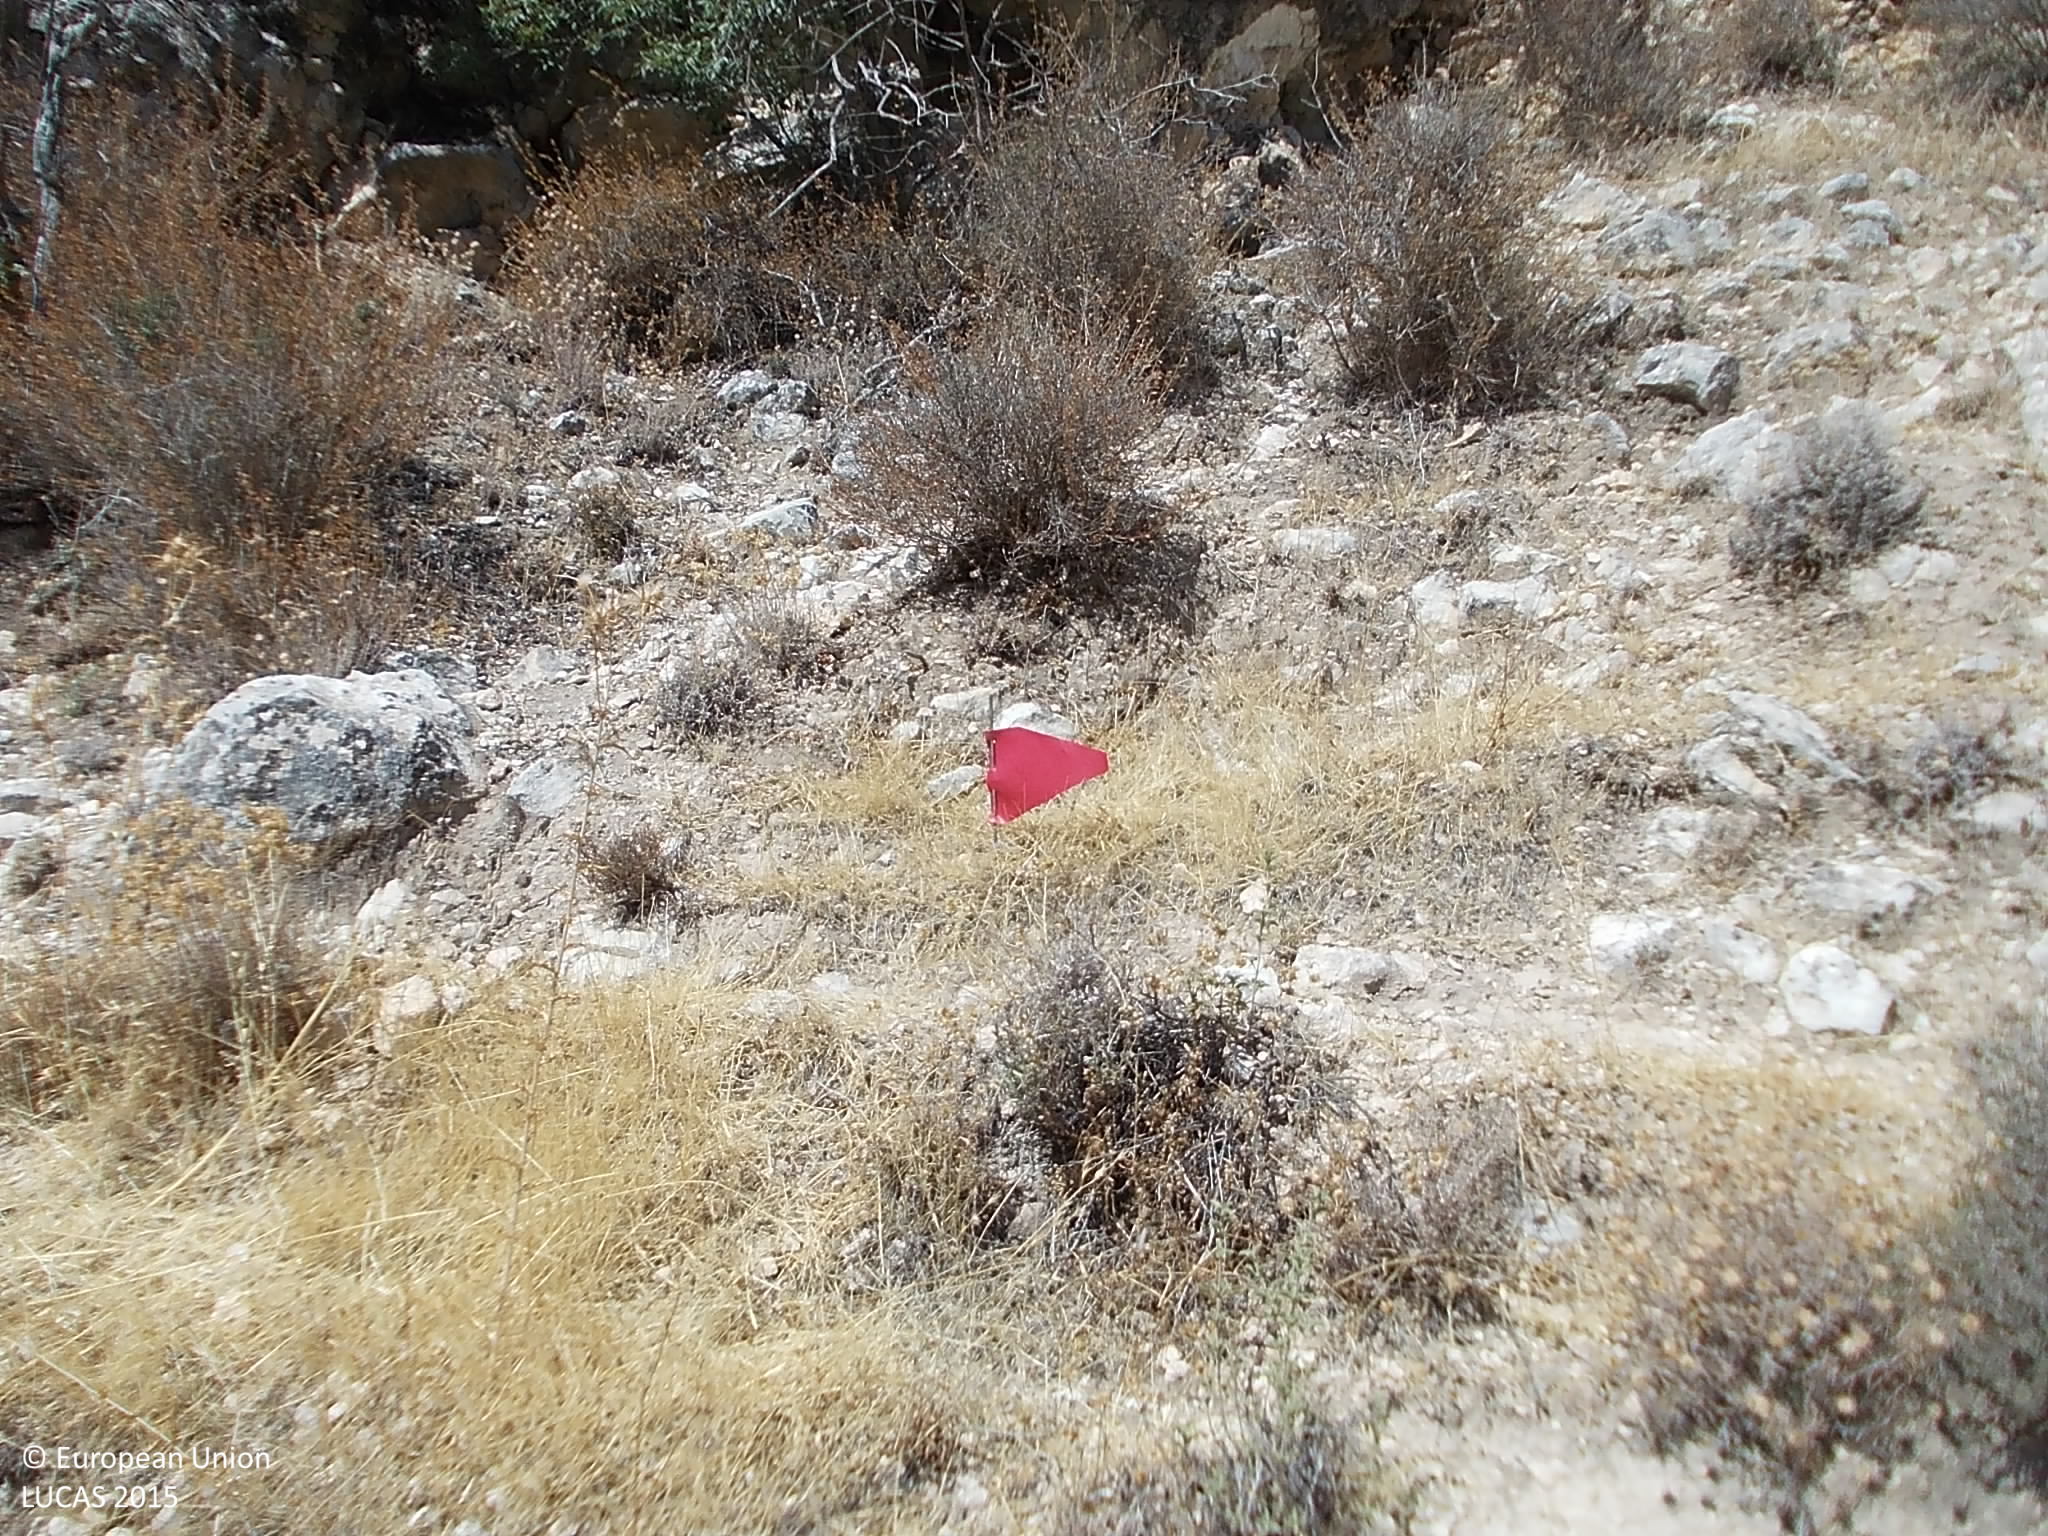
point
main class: Shrubland
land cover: Shrubland without tree cover
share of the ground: 50 - 75 %
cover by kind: shrubs 60 %, unconsolidated bare surface 20 %, herbaceous plants 10 %, consolidated bare surface 10 %
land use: Semi-natural and natural areas not in use
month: September
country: CY
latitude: 34.7331
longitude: 32.7972
